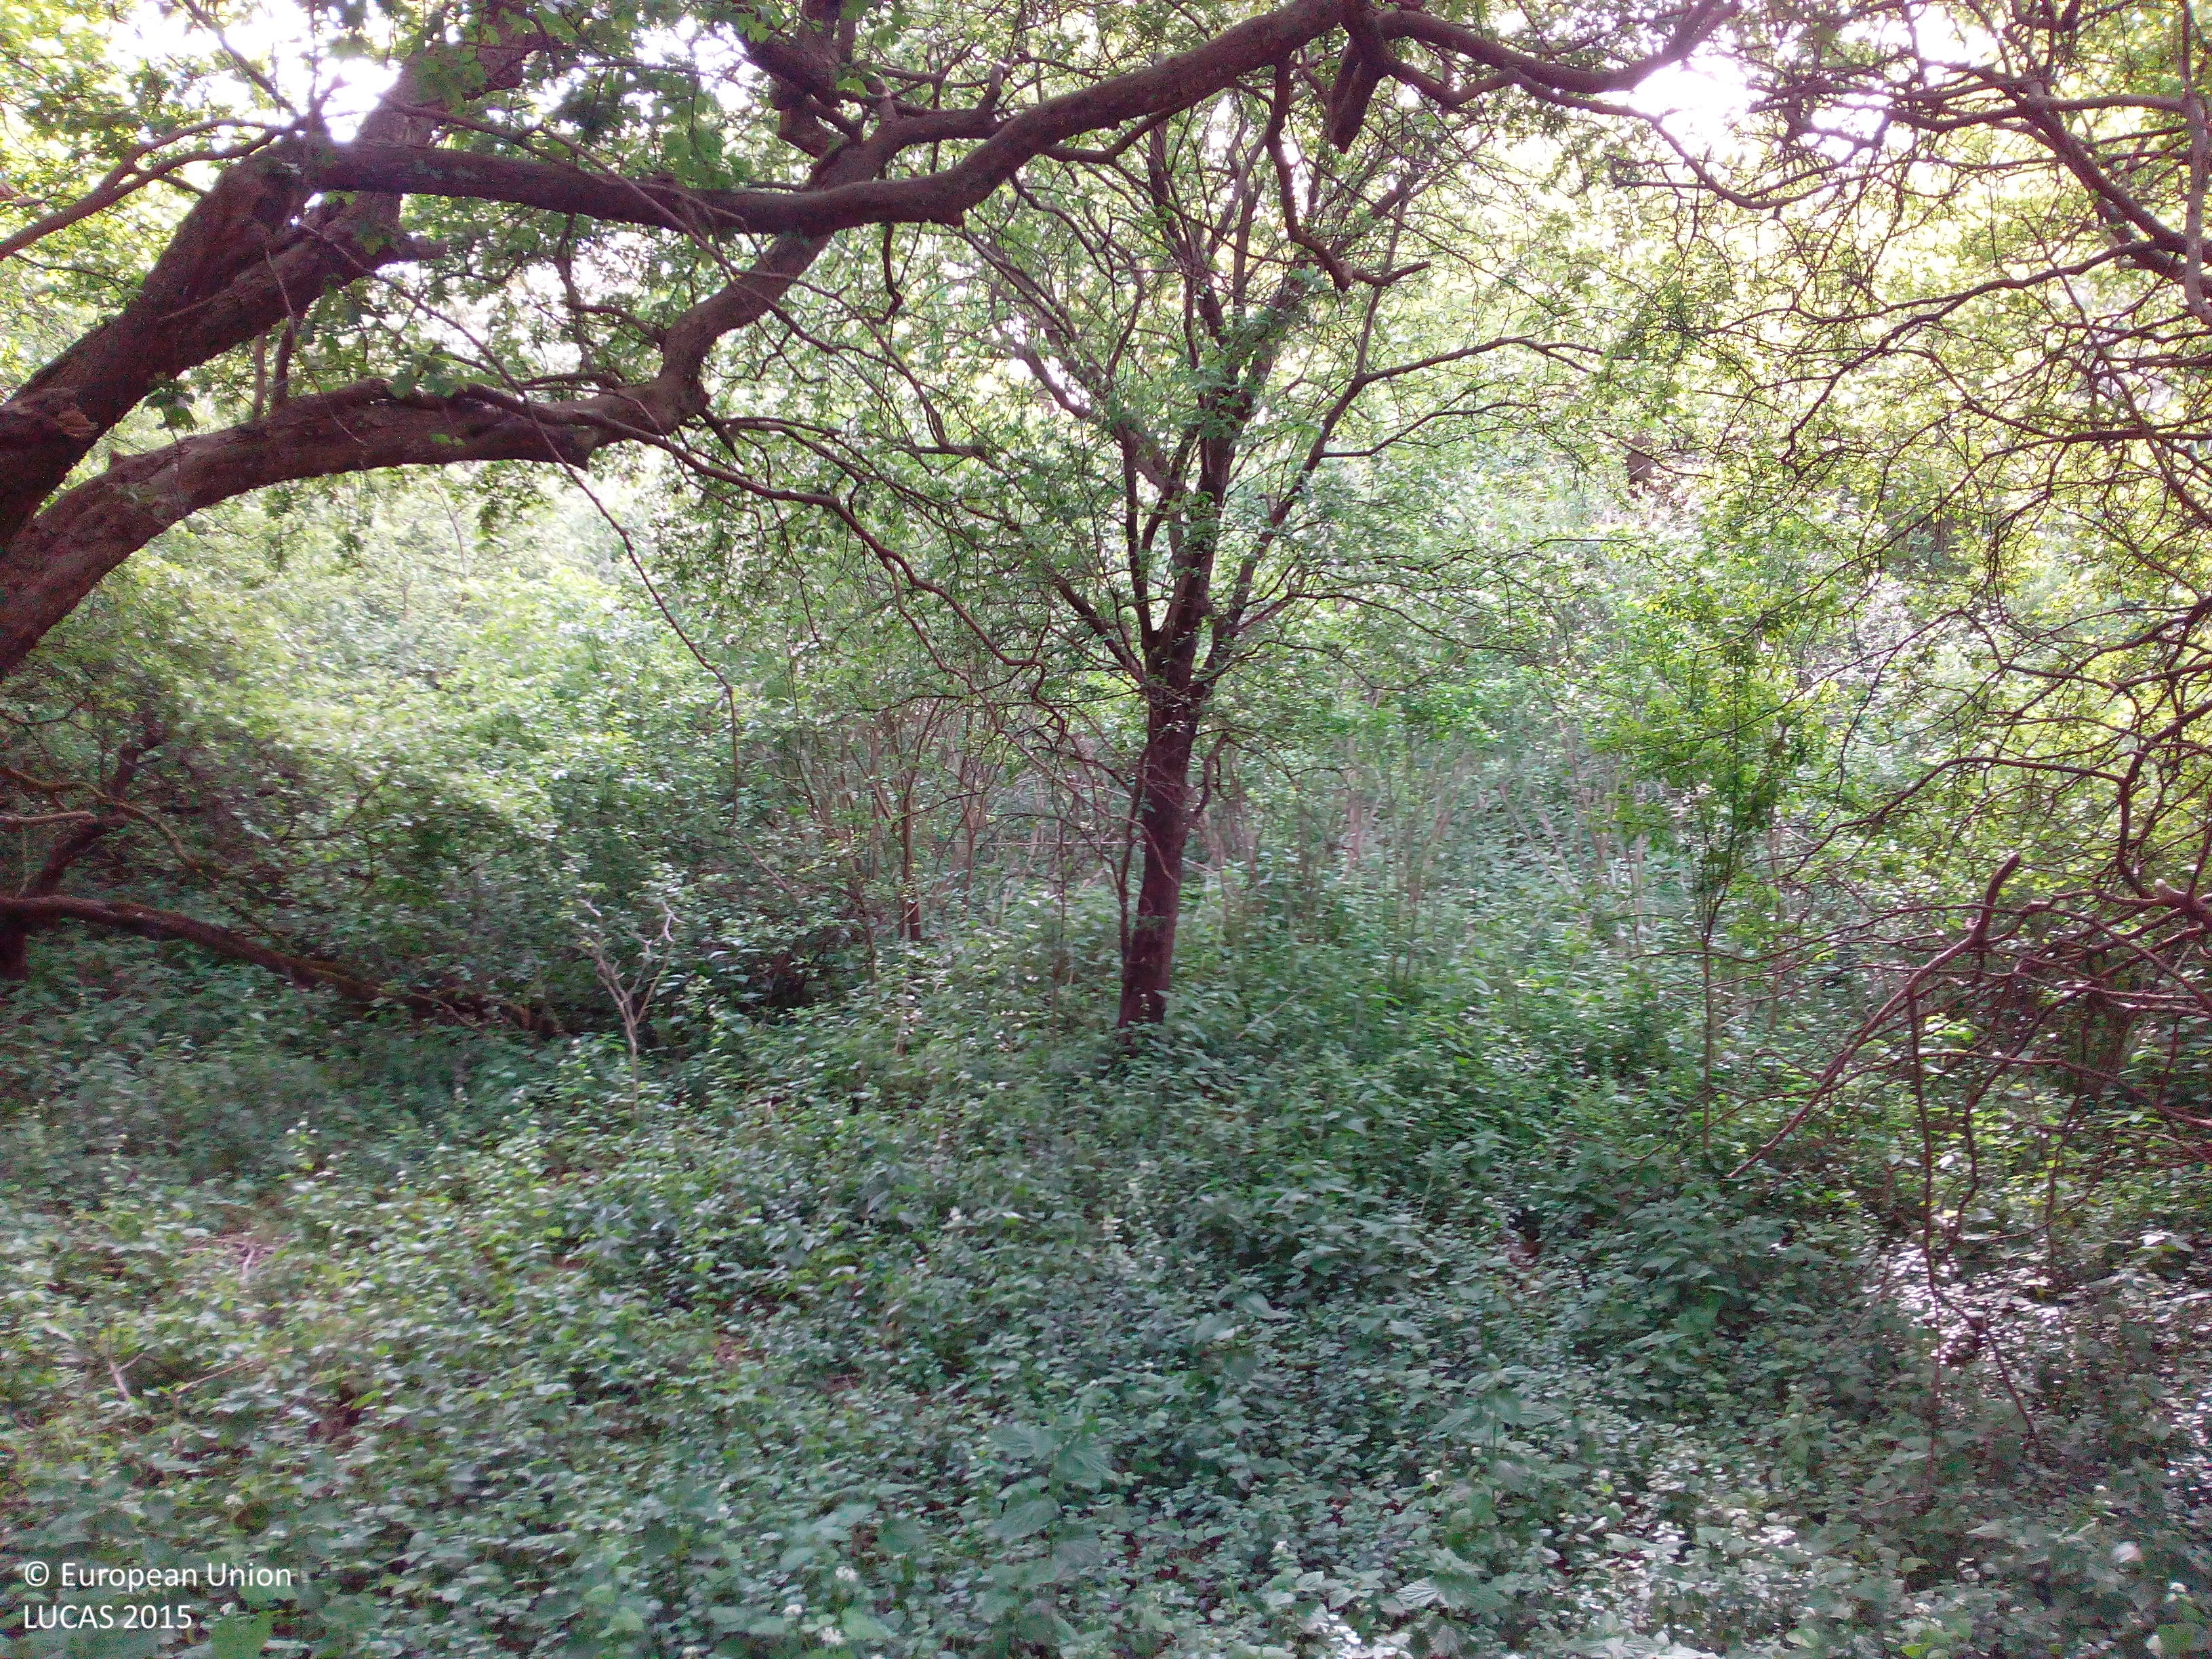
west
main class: Woodland
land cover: Broadleaved woodland
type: acidophilous oak and oak-birch forest
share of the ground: > 75 %
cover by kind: broadleaved forest trees 90 %, shrubs 10 %
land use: Semi-natural and natural areas not in use
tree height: > 5 m
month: May
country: NL
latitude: 52.4898
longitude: 4.6209
